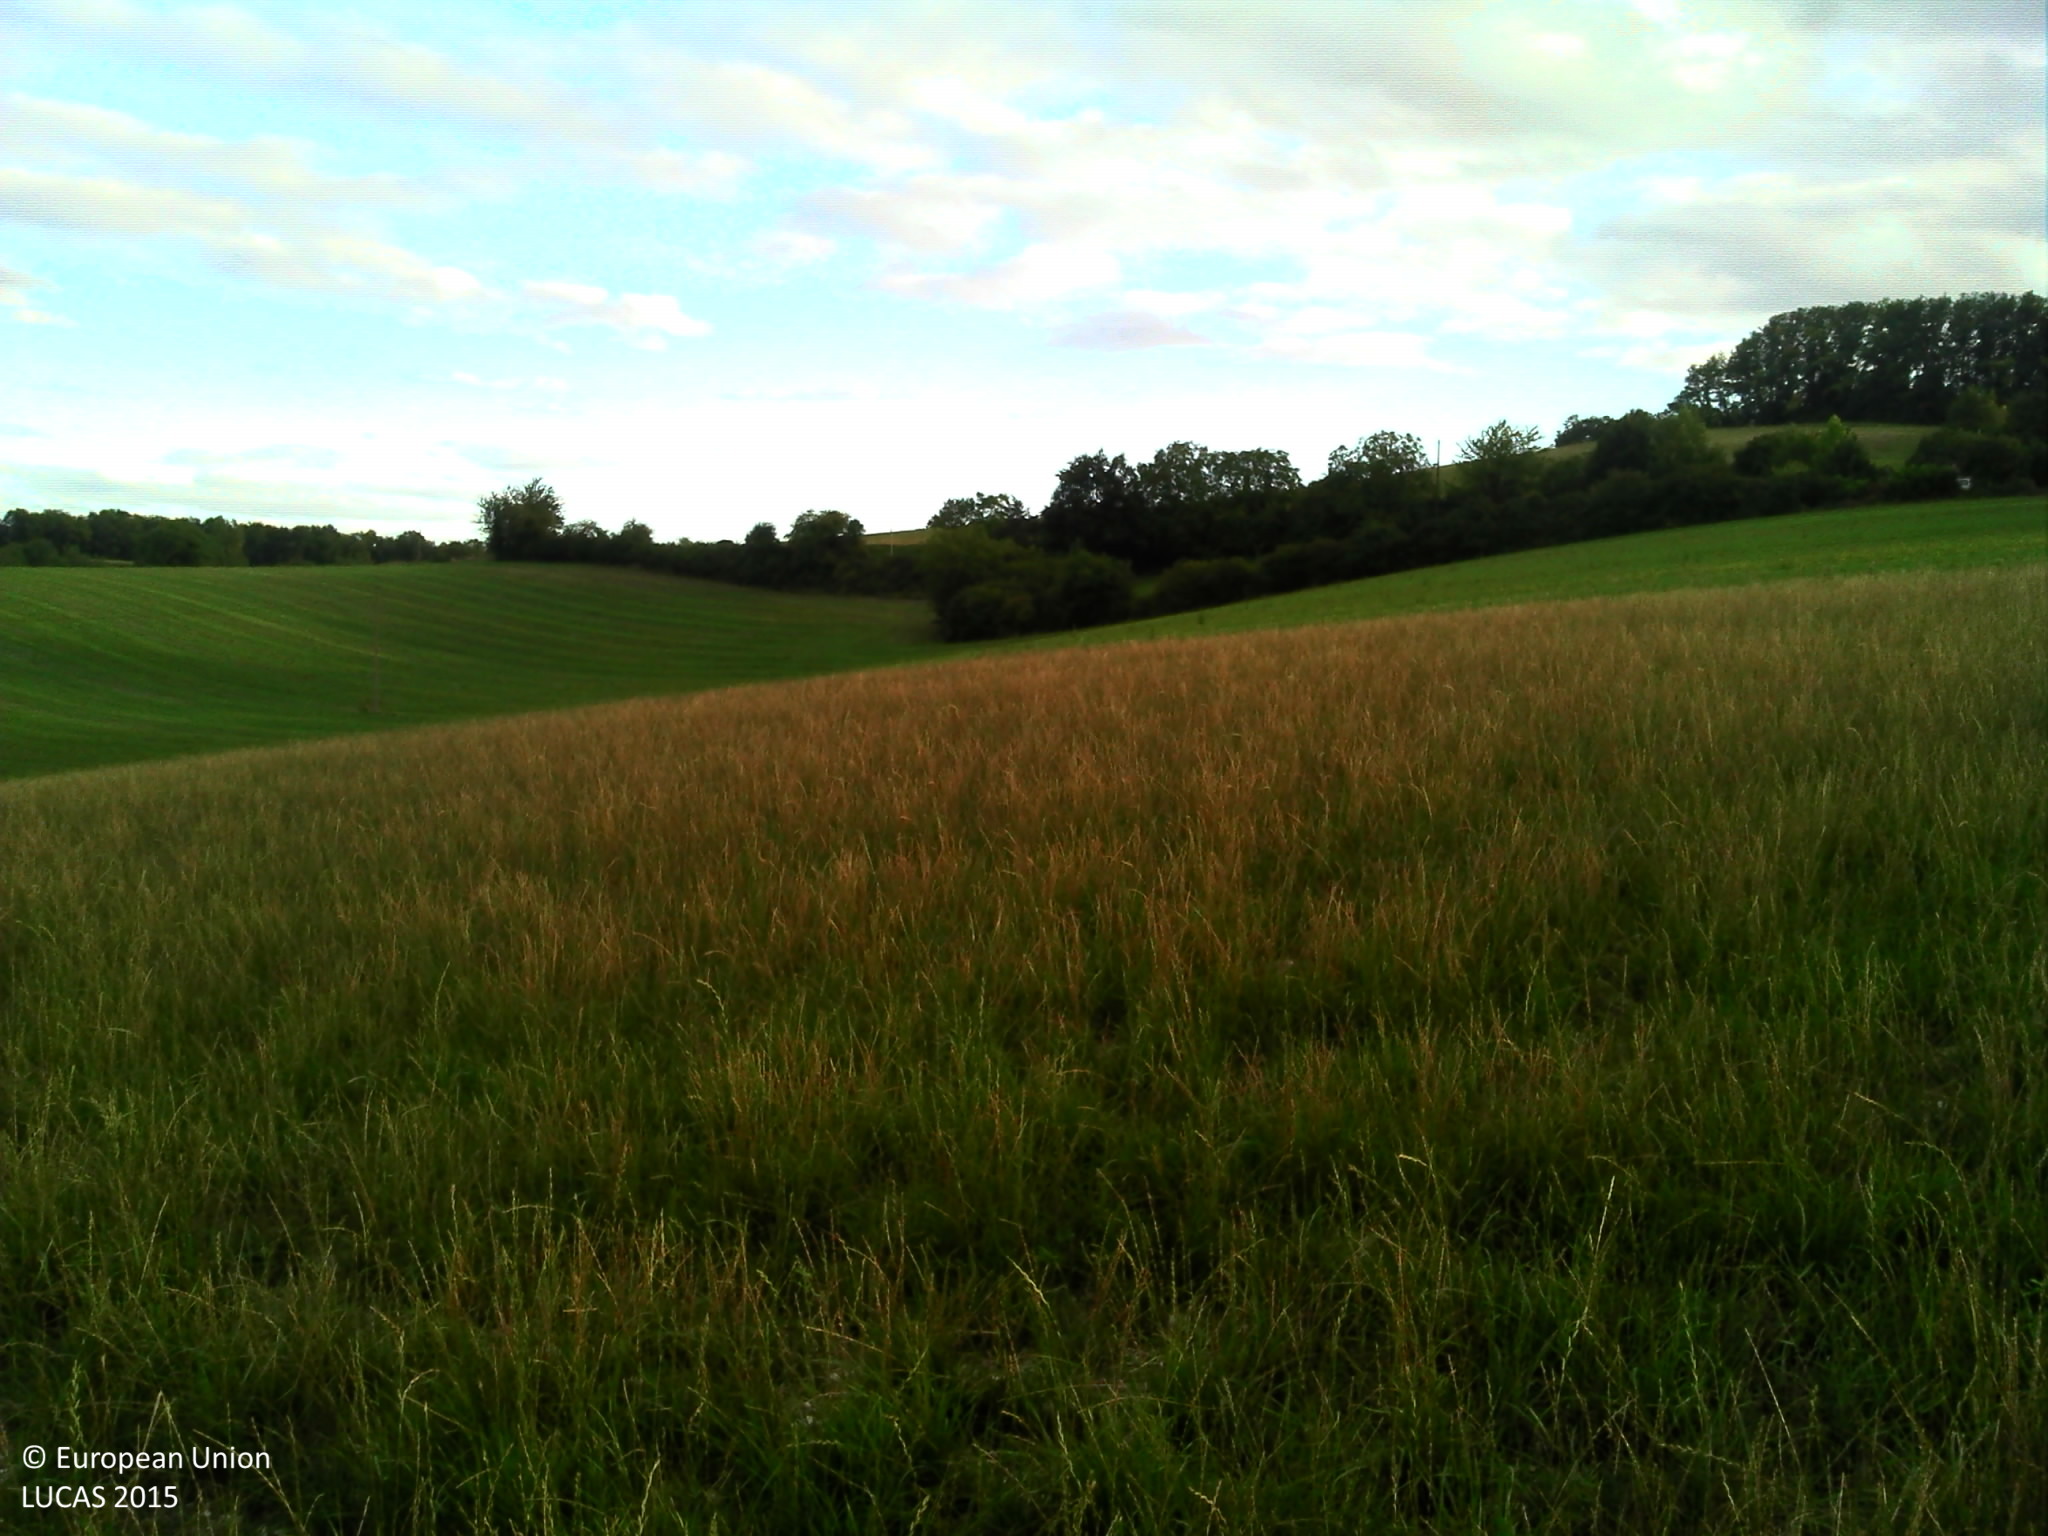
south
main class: Cropland
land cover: Temporary grasslands
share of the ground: > 75 %
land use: Agriculture (excluding fallow land and kitchen gardens)
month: August
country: FR
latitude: 45.2226
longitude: 0.5263
